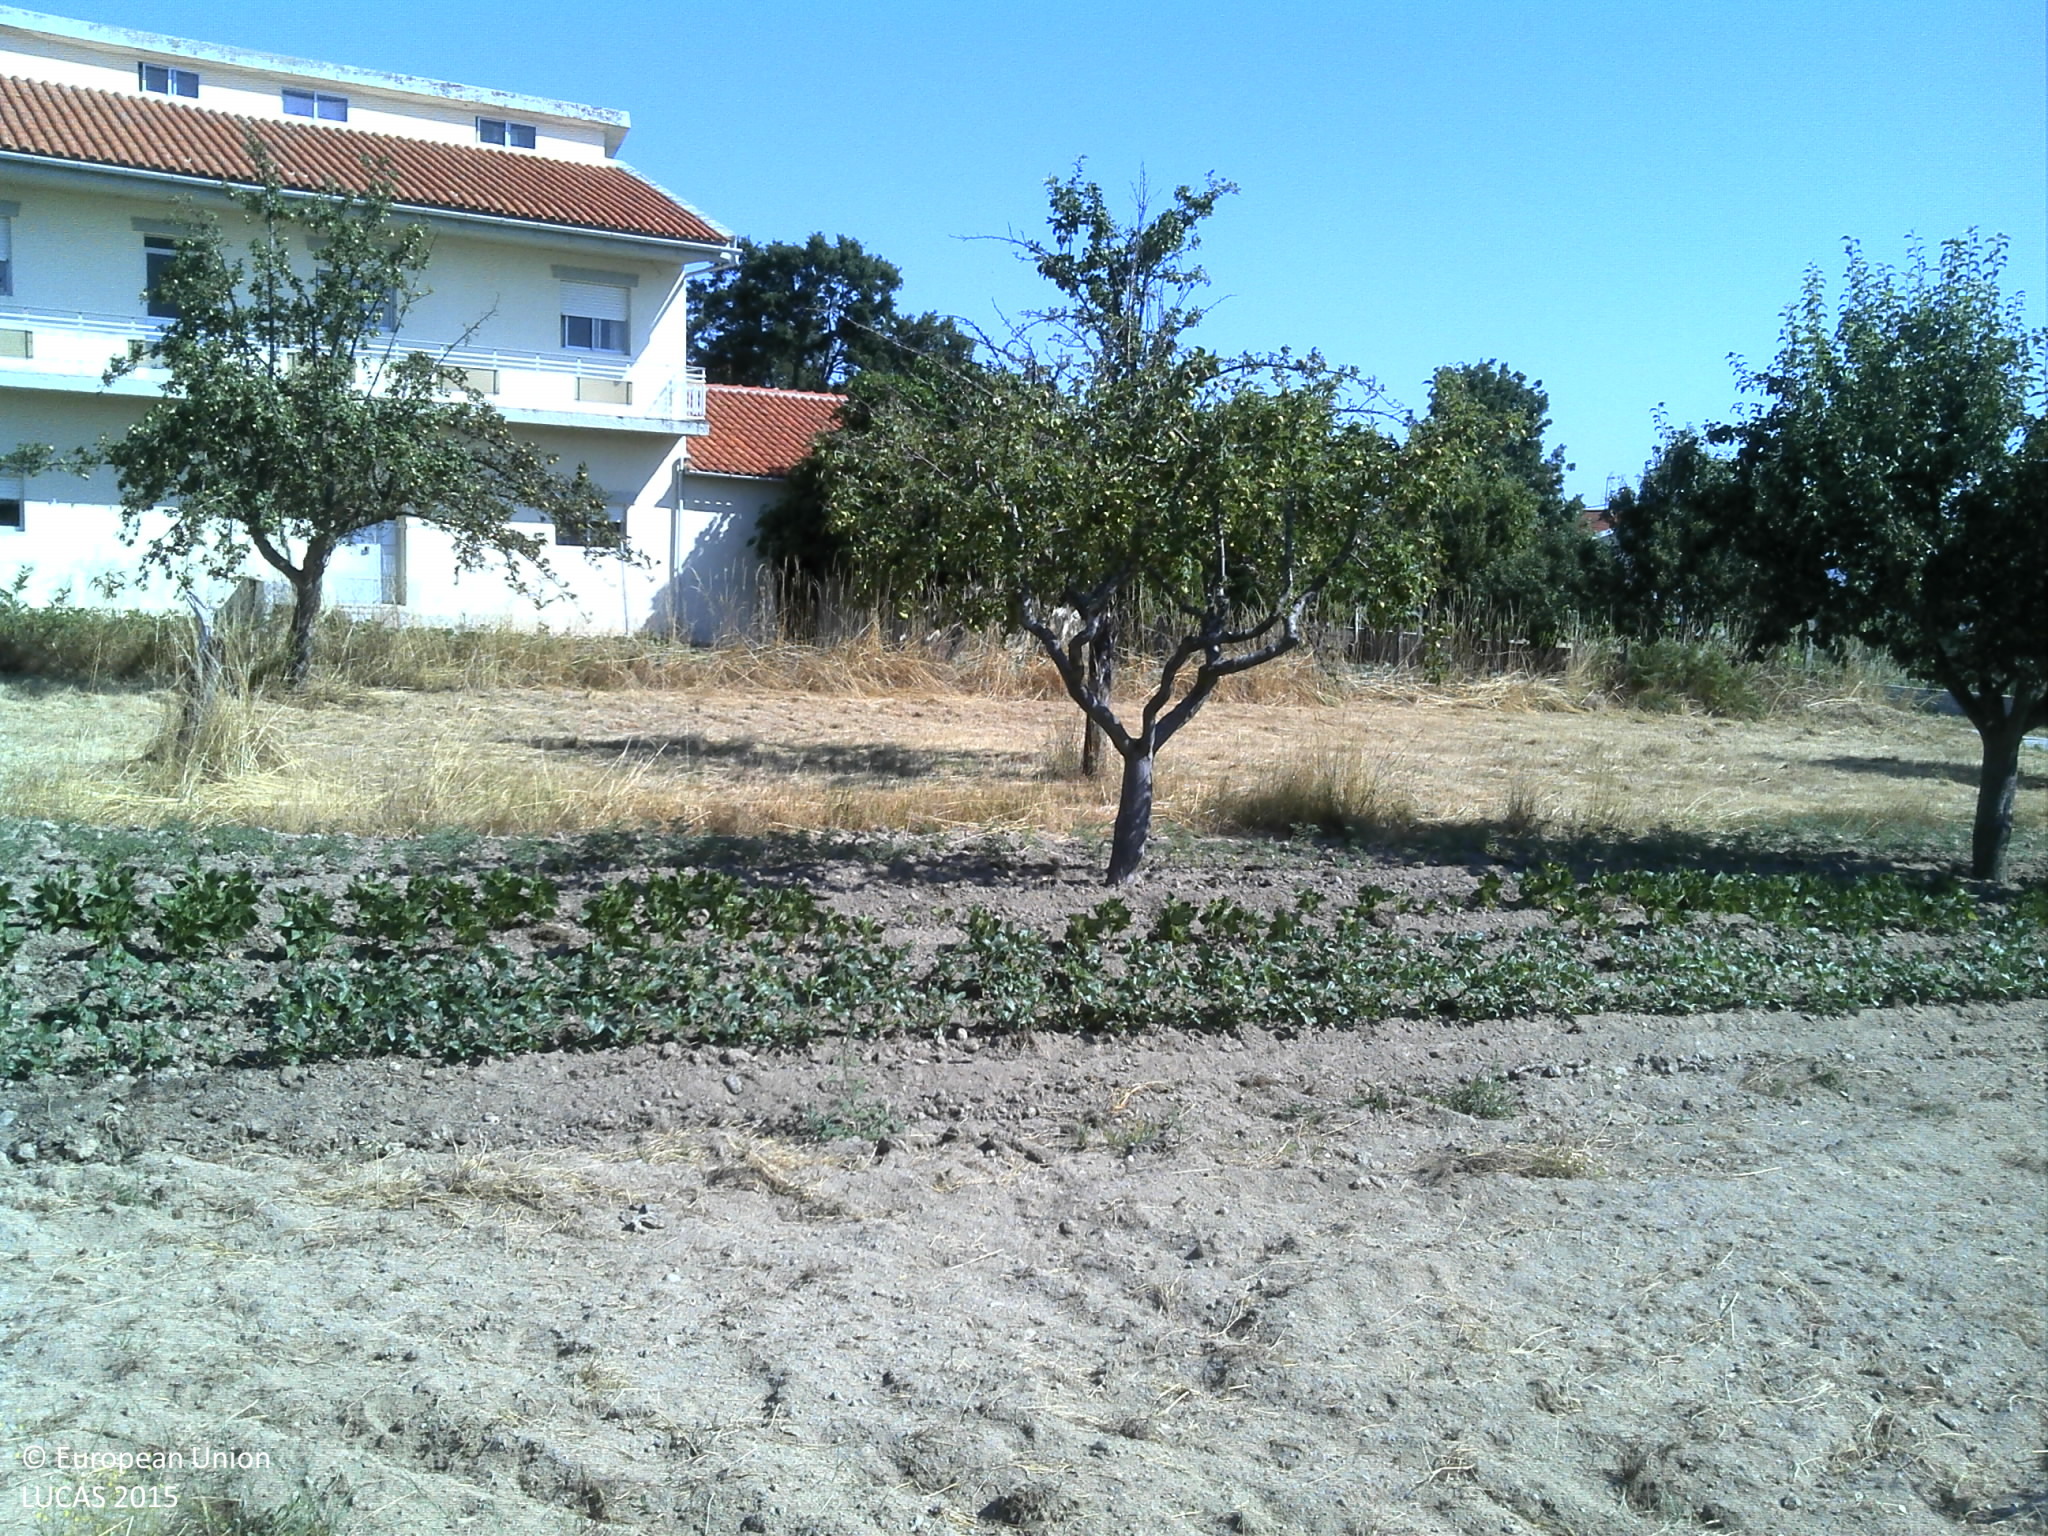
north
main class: Cropland
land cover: Other fruit trees and berries
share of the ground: 10 - 25 %
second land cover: Other bare soil
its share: > 75 %
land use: Agriculture (excluding fallow land and kitchen gardens)
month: July
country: PT
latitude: 41.8481
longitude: -7.6364
